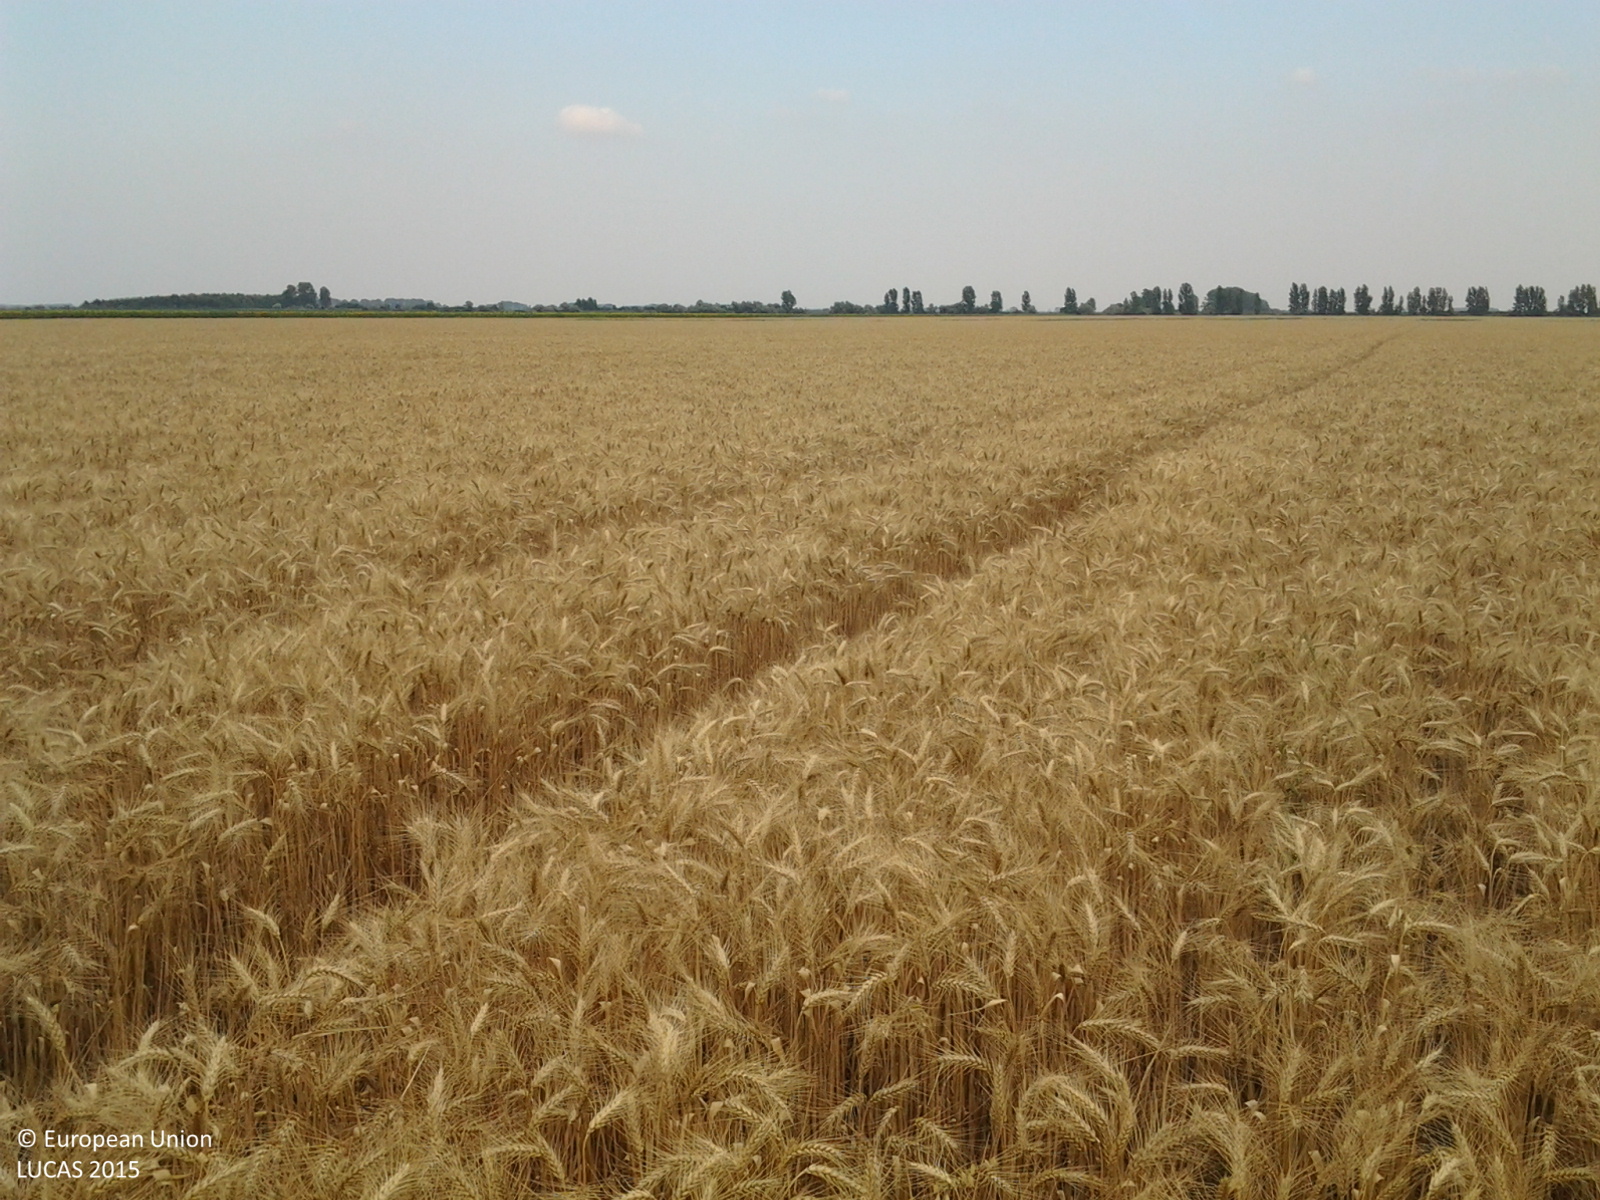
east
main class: Cropland
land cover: Common wheat
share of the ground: > 75 %
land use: Agriculture (excluding fallow land and kitchen gardens)
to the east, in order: Common wheat
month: July
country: HU
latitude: 47.4029
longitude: 20.2176
